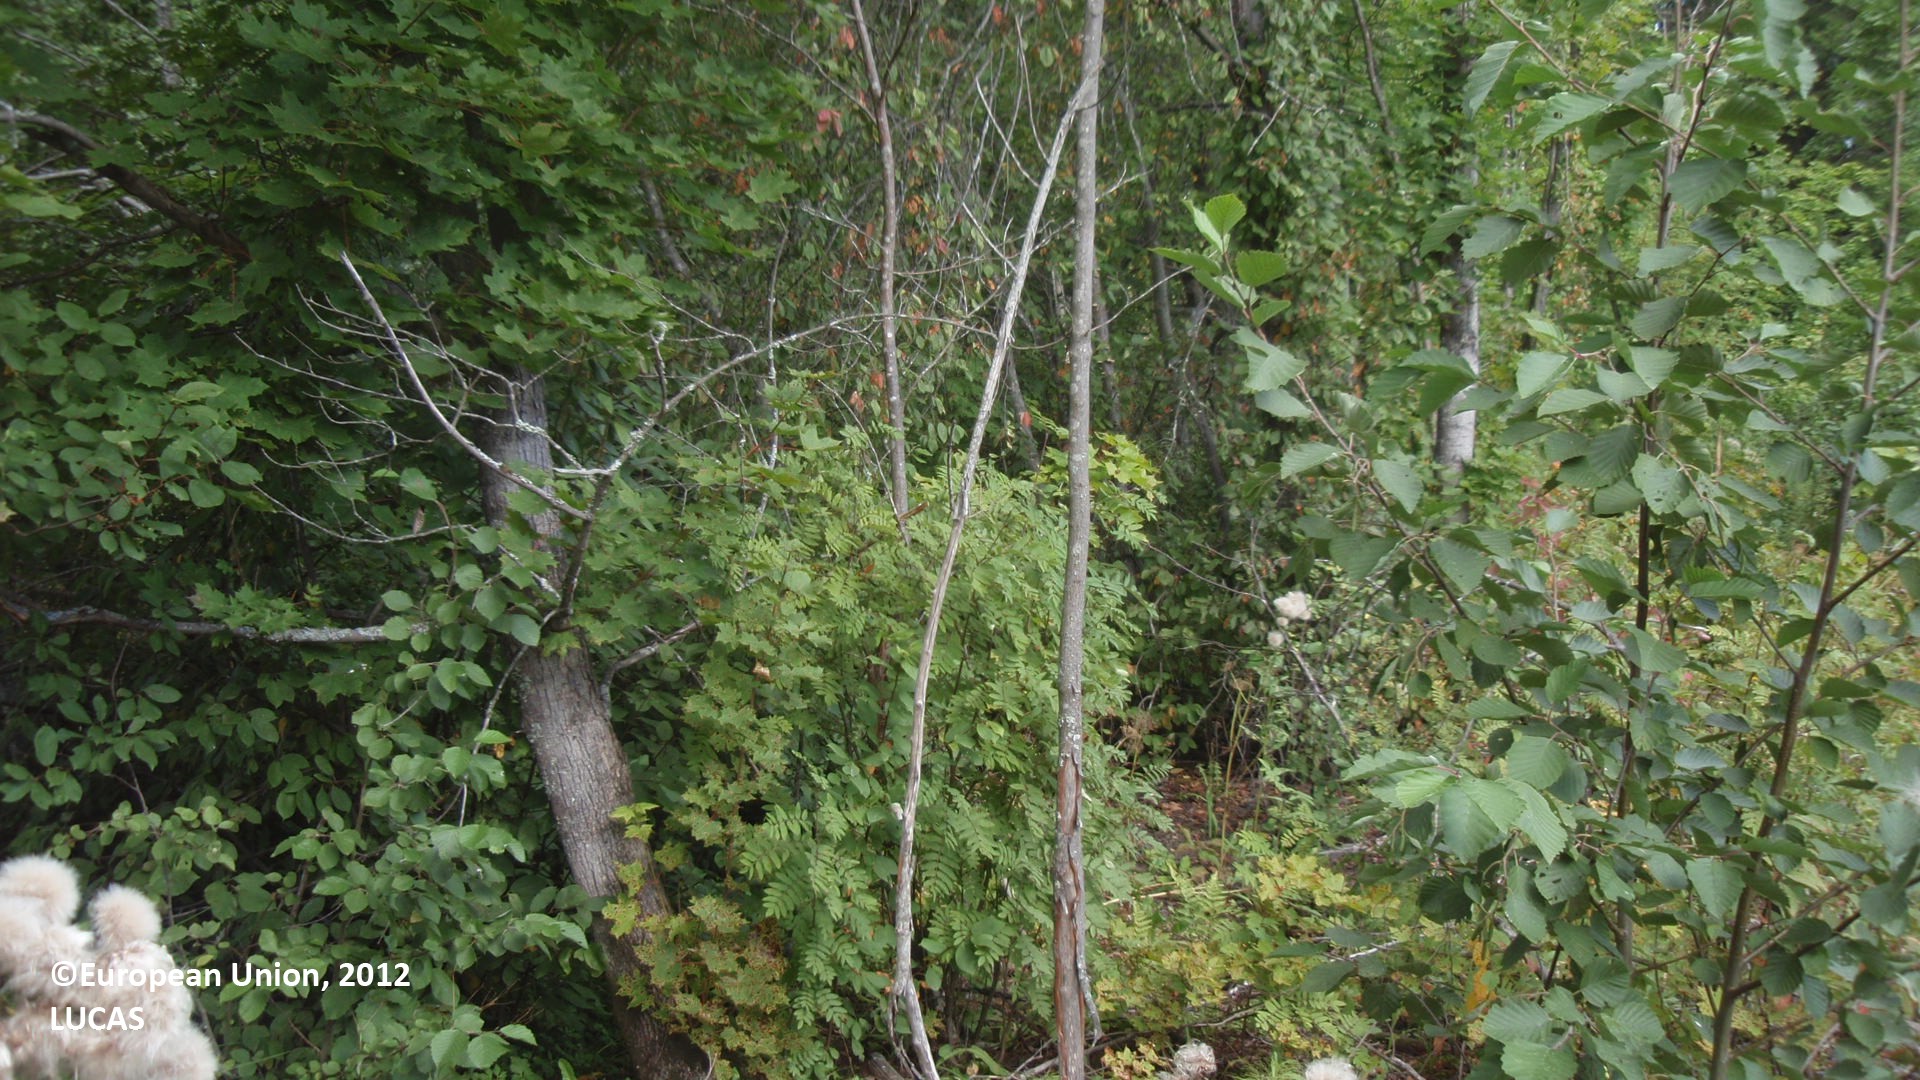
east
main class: Woodland
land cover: Broadleaved woodland
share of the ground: > 75 %
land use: Forestry
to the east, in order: Broadleaved woodland; Spruce dominated mixed woodland; Inland running water; Broadleaved woodland
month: August
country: FI
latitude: 60.8843
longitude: 26.6085
